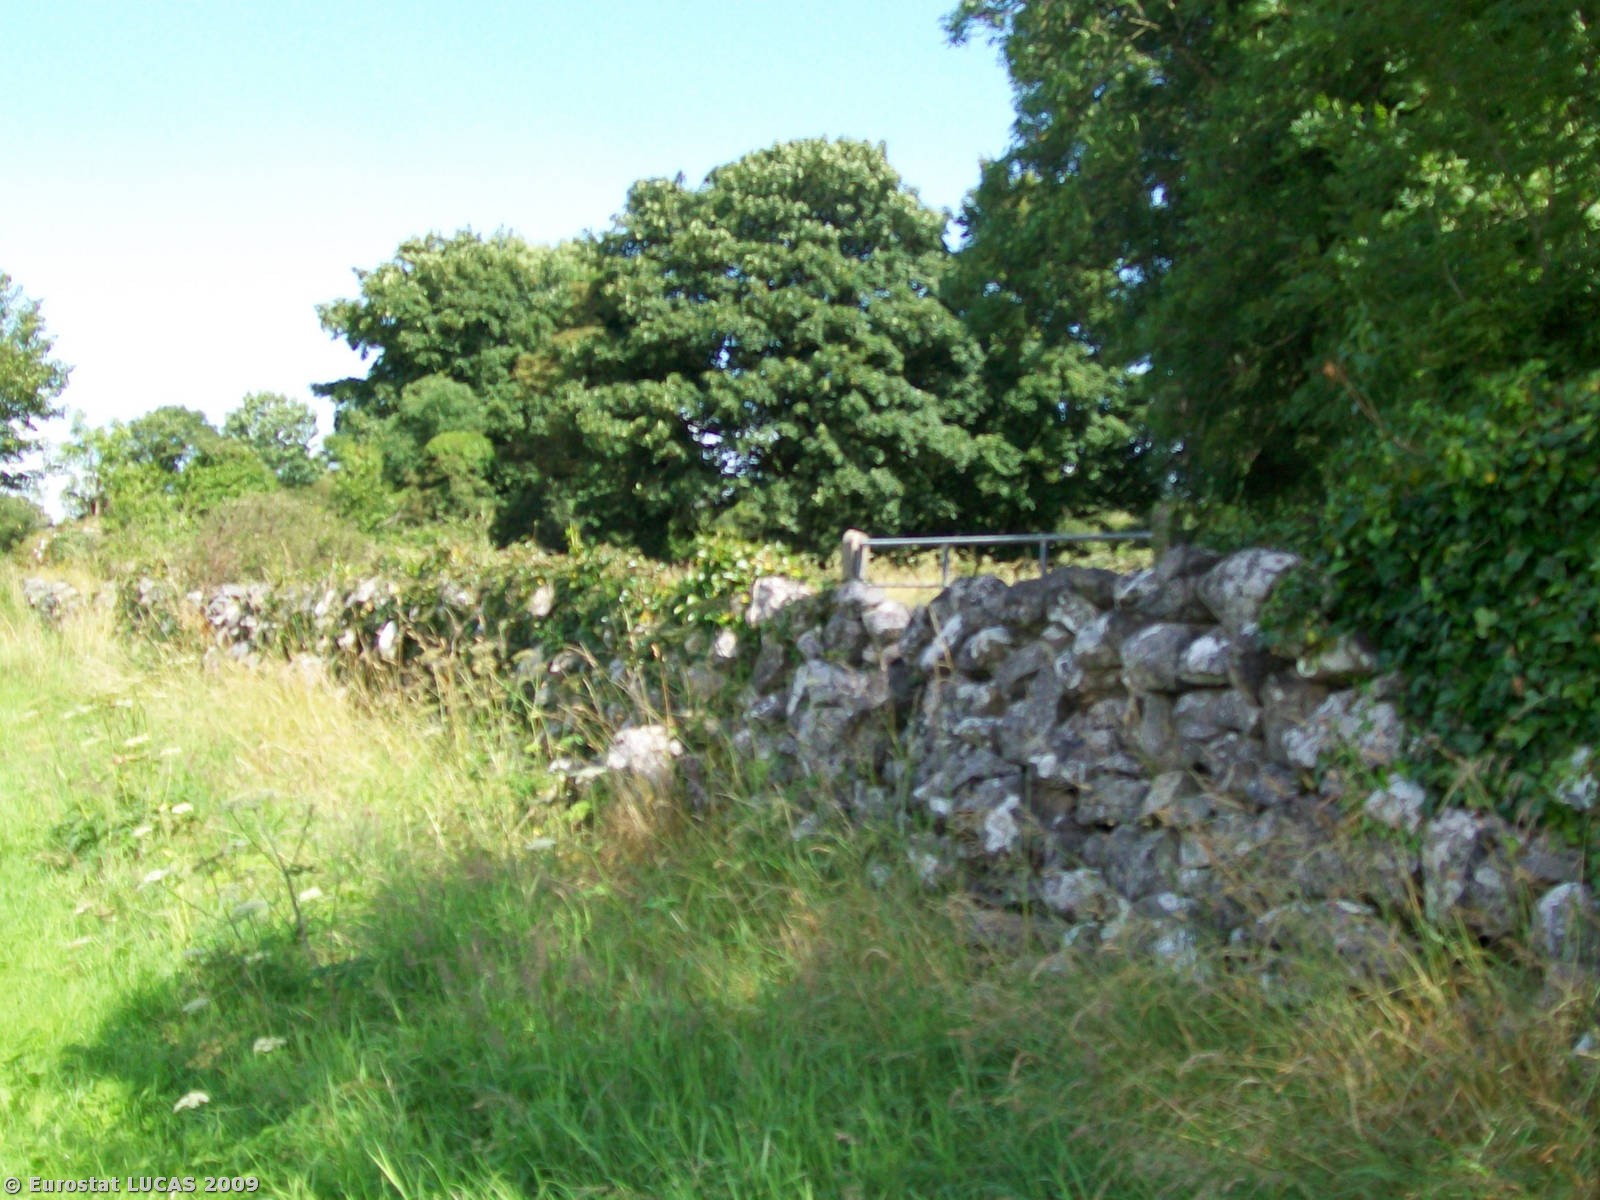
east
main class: Grassland
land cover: Grassland without tree/shrub cover
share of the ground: > 75 %
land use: Agriculture (excluding fallow land and kitchen gardens)
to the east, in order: Grassland without tree/shrub cover; Dry stone walls; Tracks; Broadleaved woodland; Dry stone walls; Grassland without tree/shrub cover; Abandoned hedges; Dry stone walls; Grassland without tree/shrub cover
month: July
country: IE
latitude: 53.1811
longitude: -8.7112
